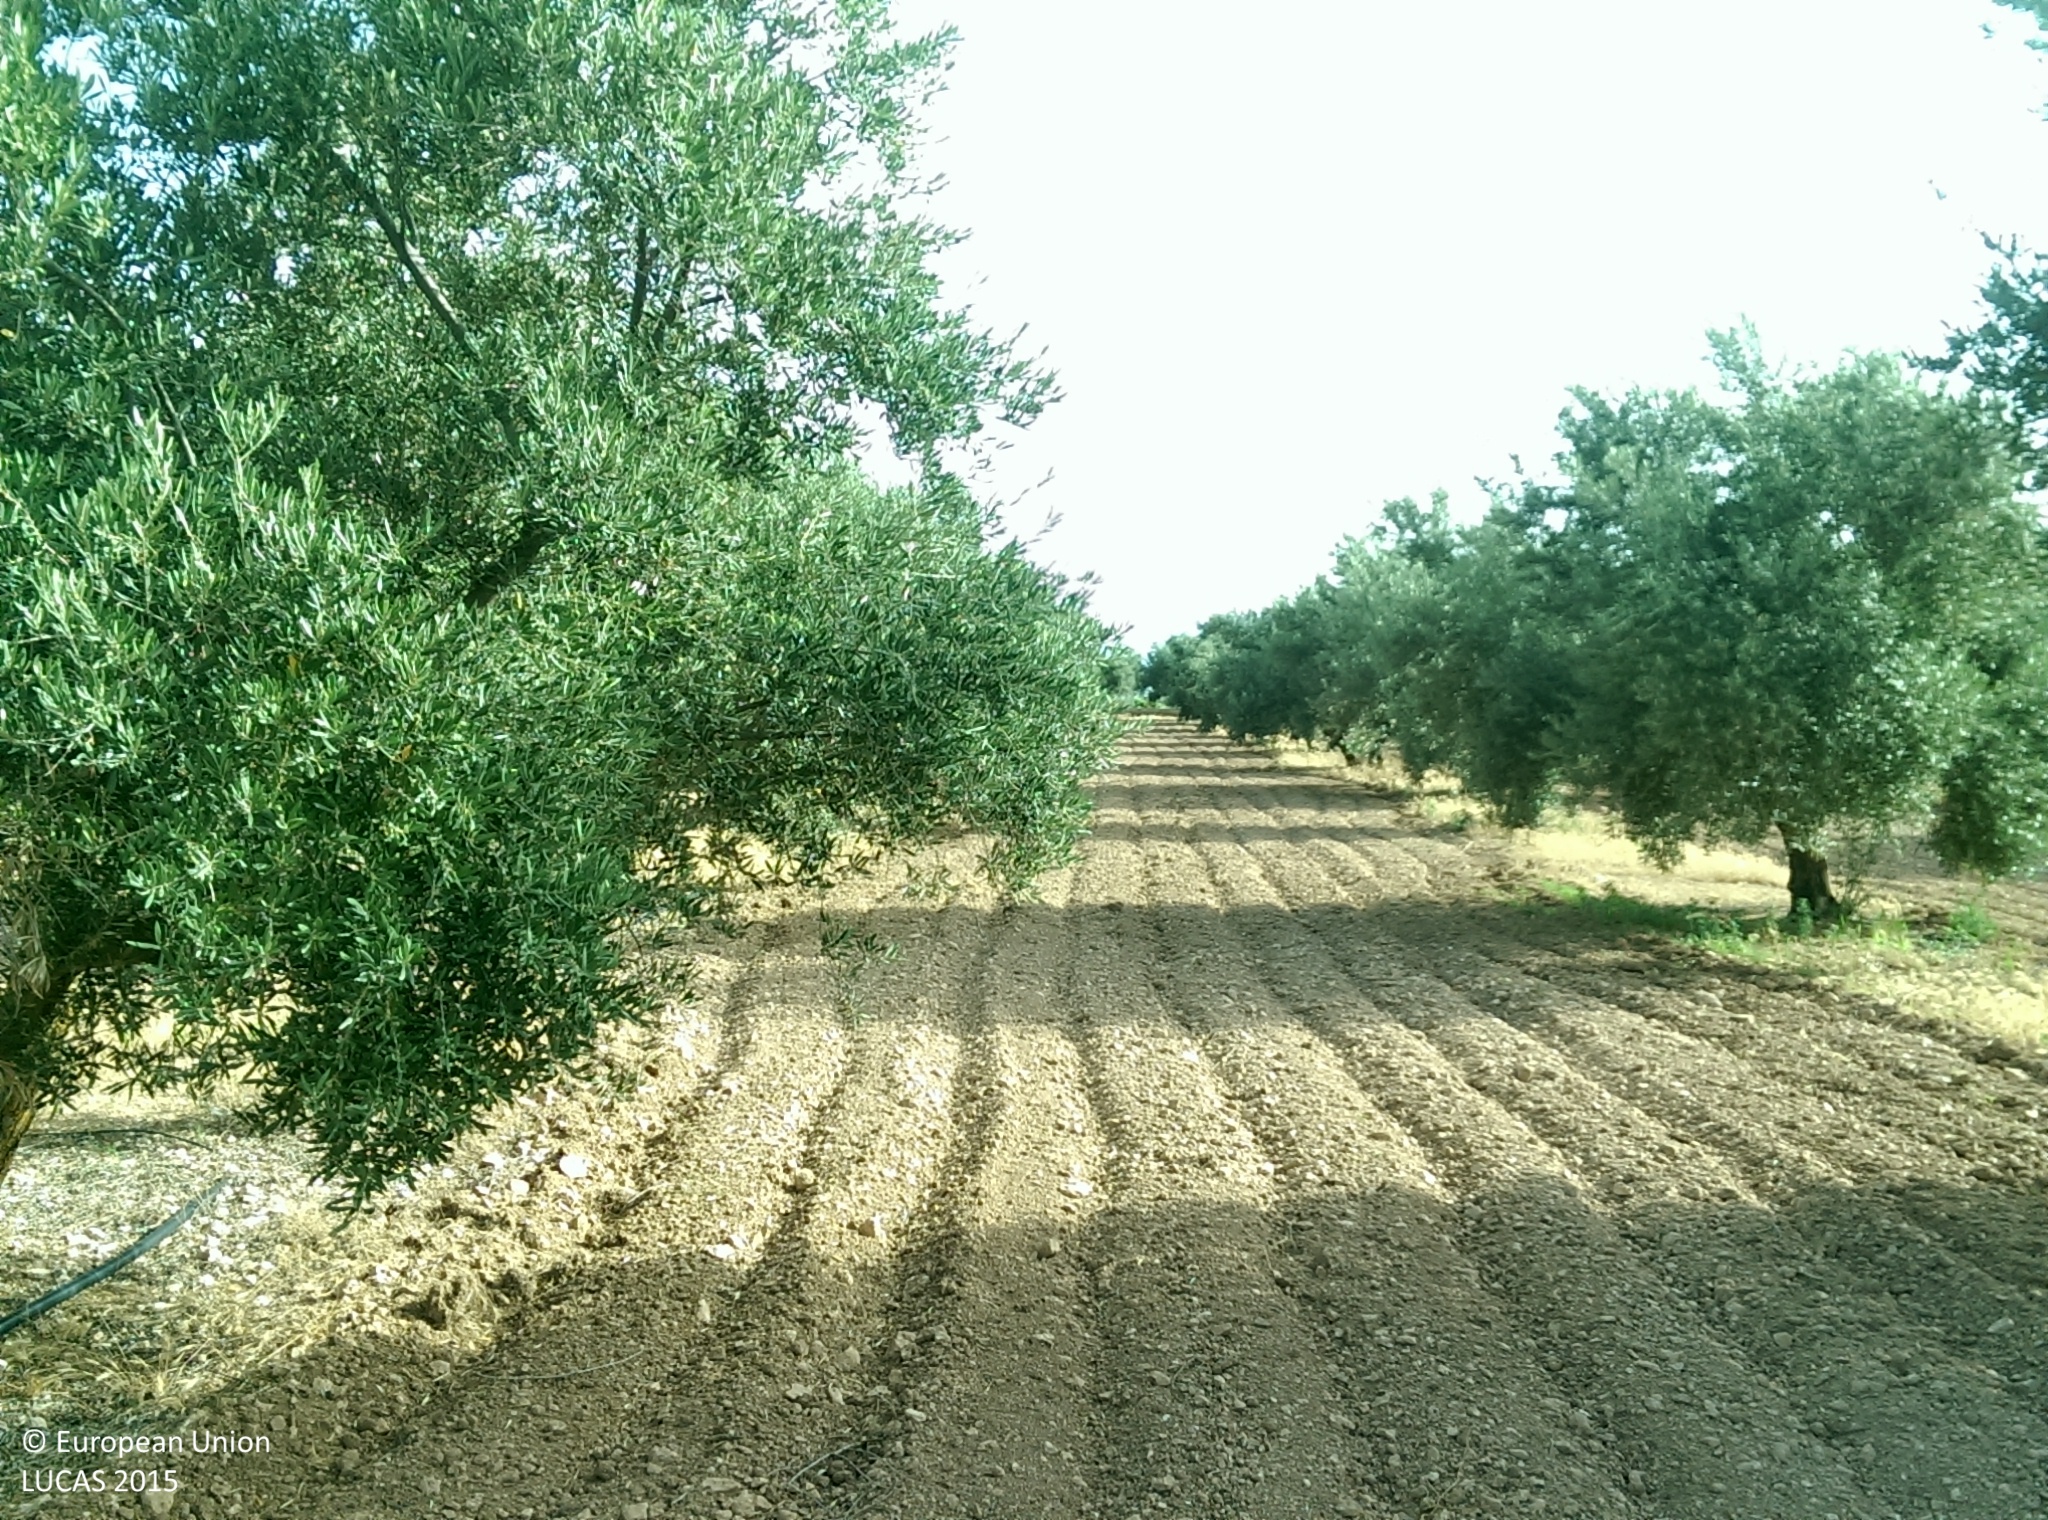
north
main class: Cropland
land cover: Olive groves
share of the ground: 50 - 75 %
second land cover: Other bare soil
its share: > 75 %
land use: Agriculture (excluding fallow land and kitchen gardens)
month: July
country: ES
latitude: 37.6146
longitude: -2.9163
